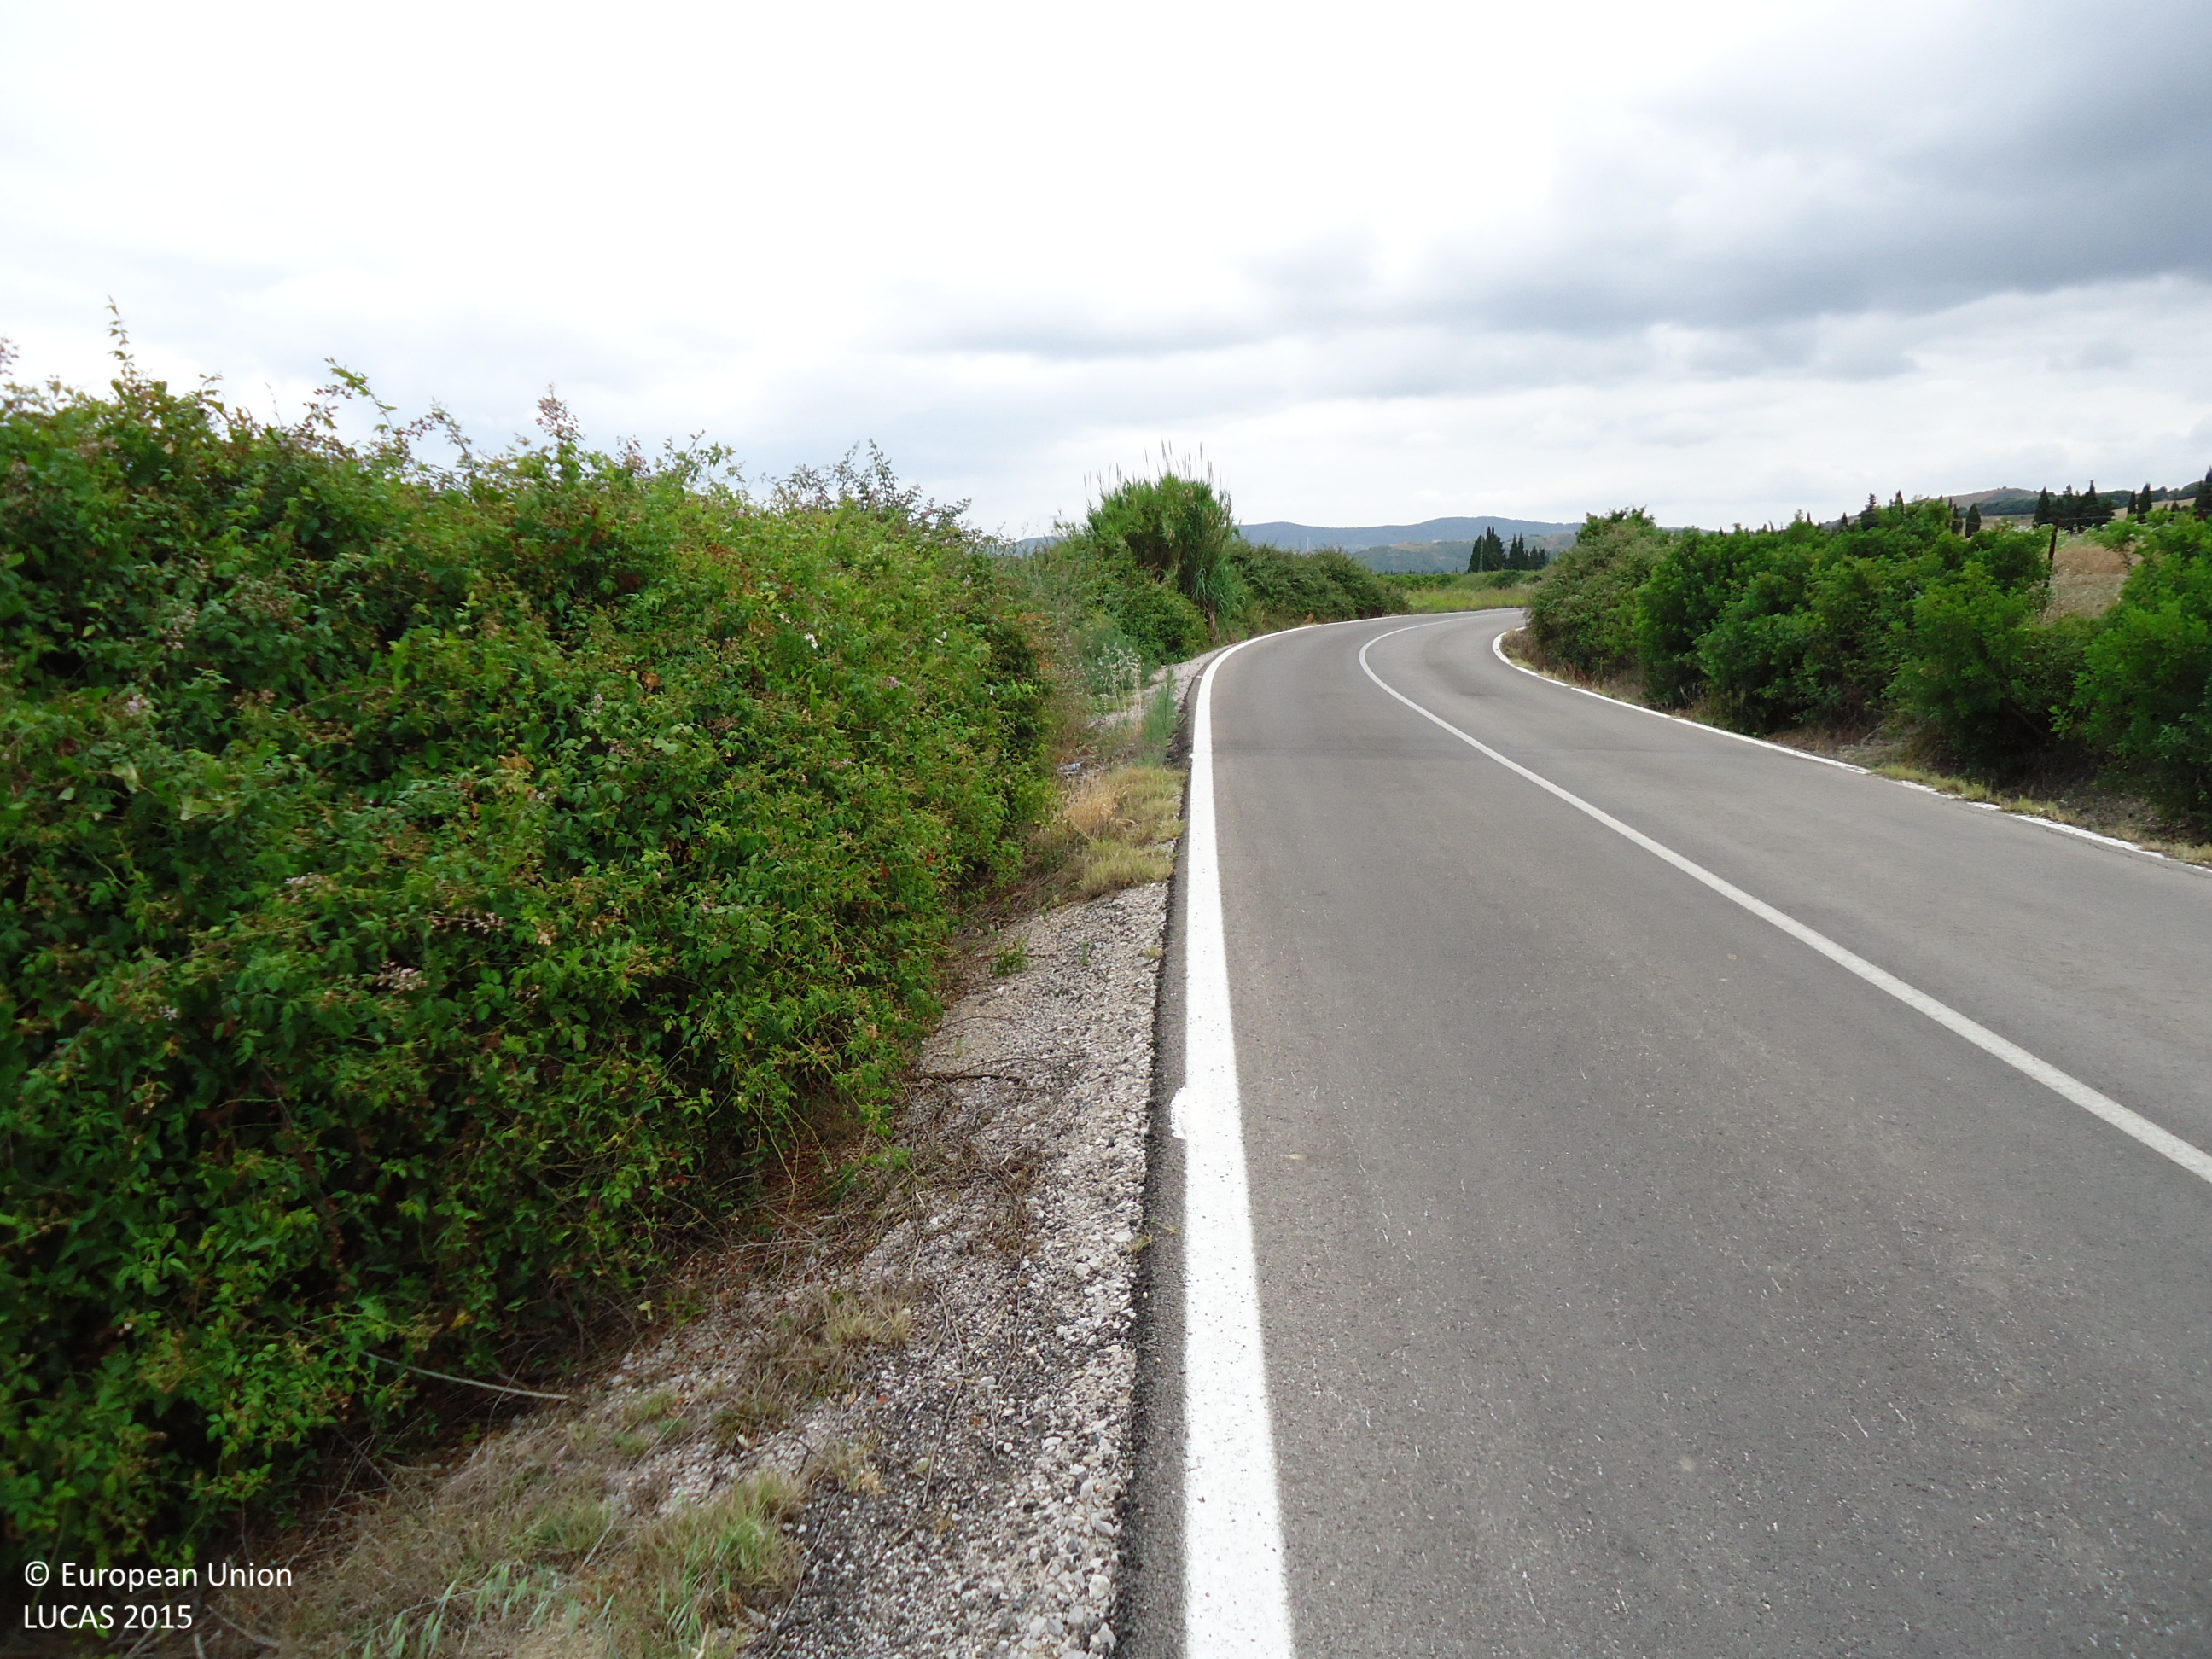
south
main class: Cropland
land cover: Lucerne
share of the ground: > 75 %
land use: Agriculture (excluding fallow land and kitchen gardens)
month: June
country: ES
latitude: 36.3693
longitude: -5.3194
